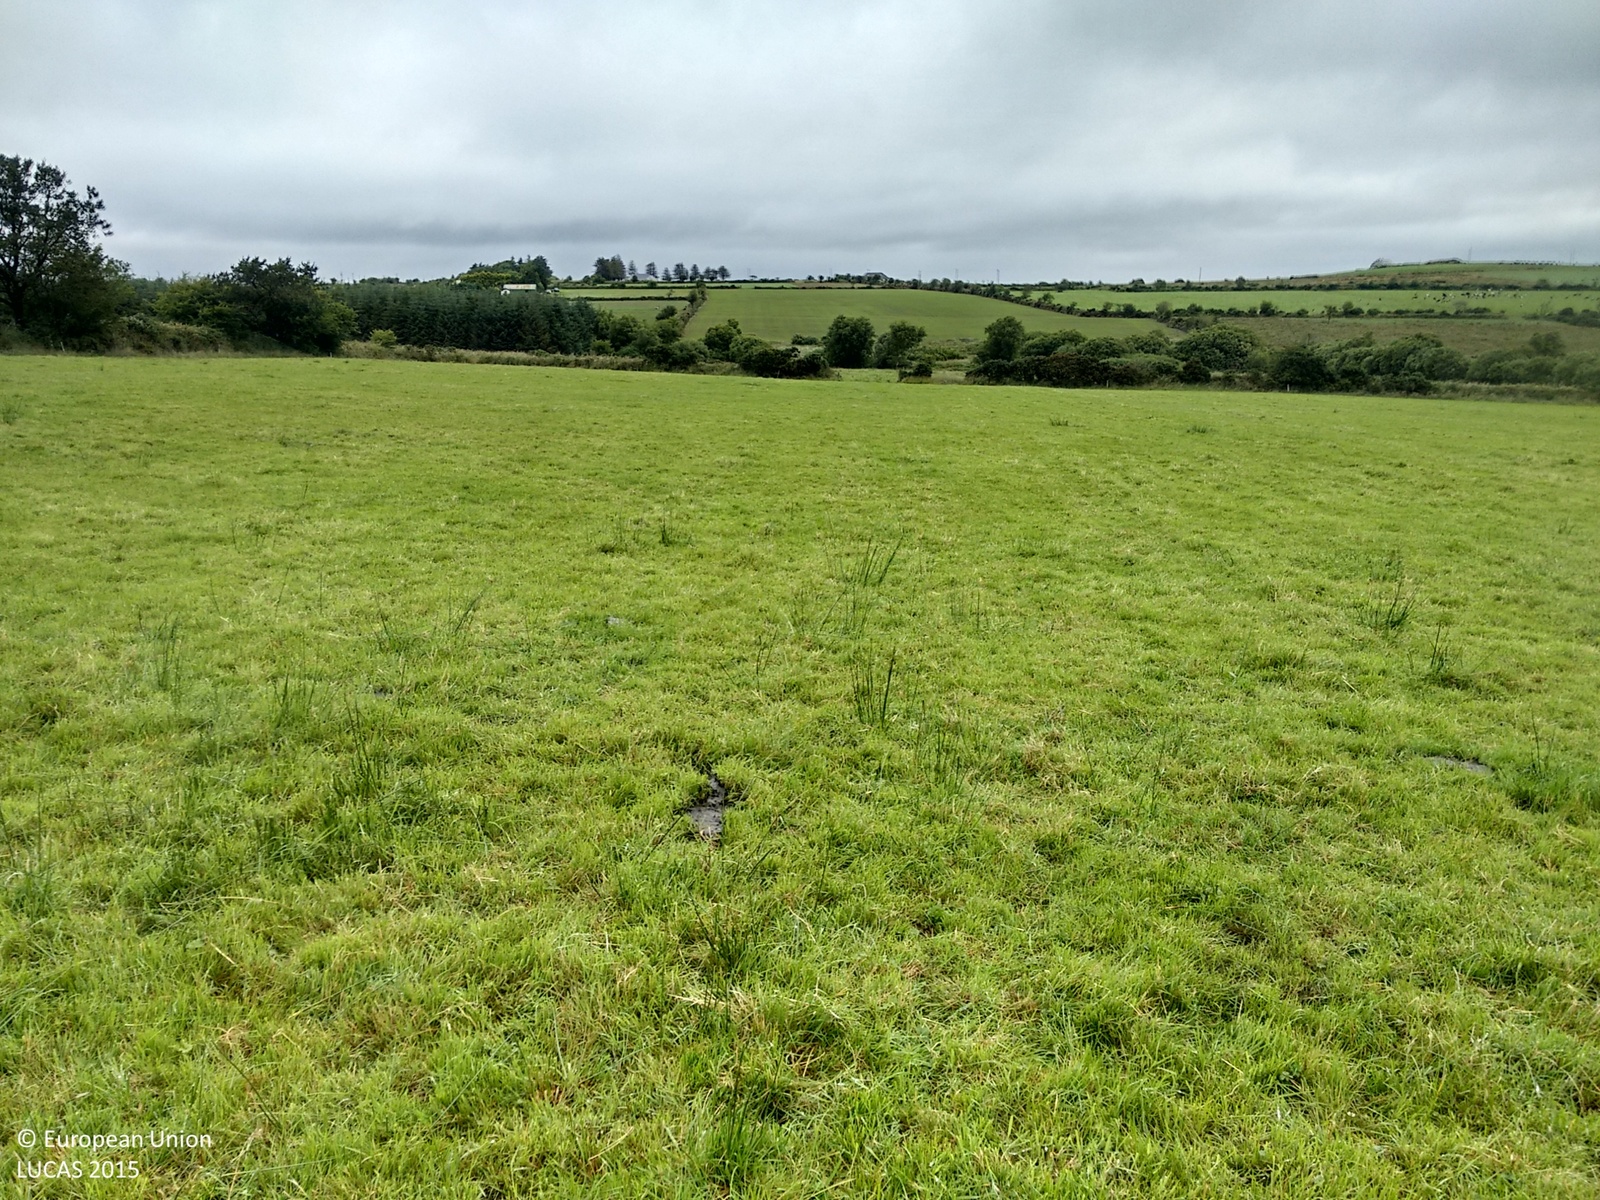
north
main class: Grassland
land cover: Grassland without tree/shrub cover
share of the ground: > 75 %
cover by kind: herbaceous plants 100 %
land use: Agriculture (excluding fallow land and kitchen gardens)
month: July
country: IE
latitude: 52.0859
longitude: -8.3885
